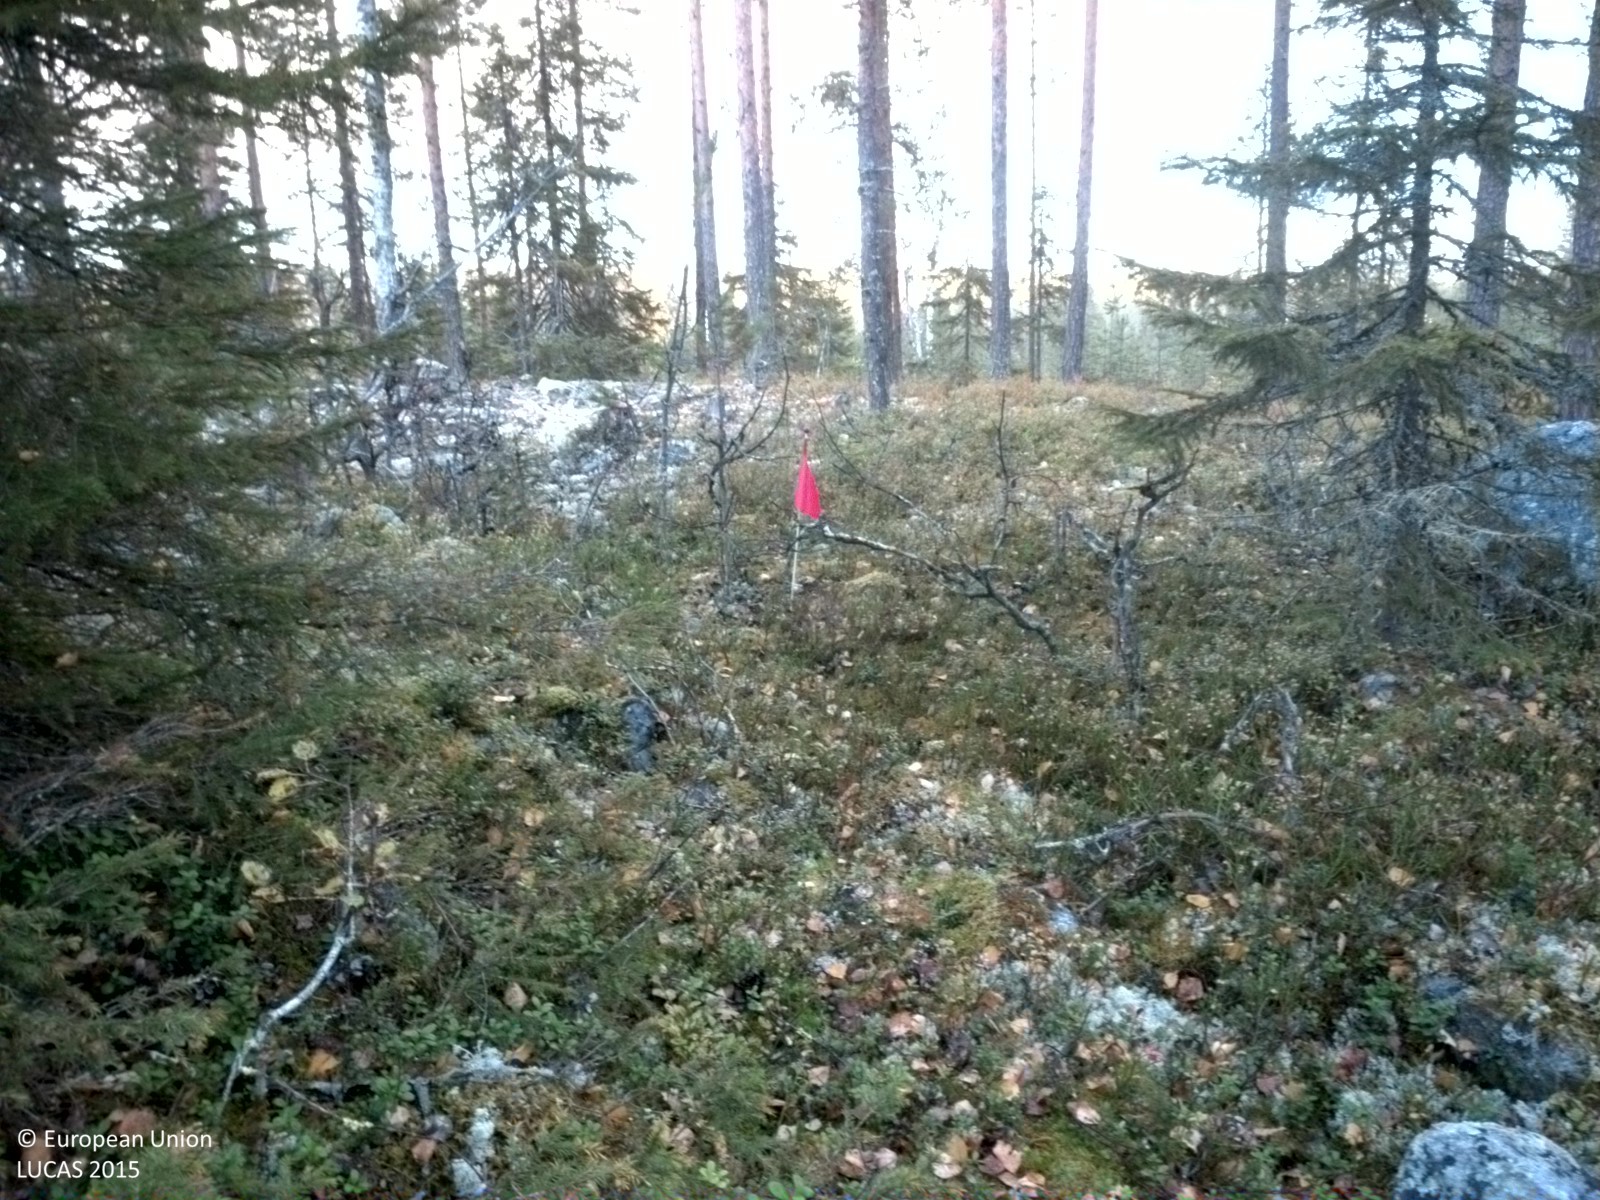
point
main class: Woodland
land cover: Pine dominated coniferous woodland
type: boreal forest
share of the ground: 25 - 50 %
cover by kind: shrubs 50 %, coniferous forest trees 30 %, lichens and mosses 10 %, consolidated bare surface 10 %
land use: Forestry
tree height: > 5 m
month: October
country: SE
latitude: 65.9891
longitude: 22.0649
